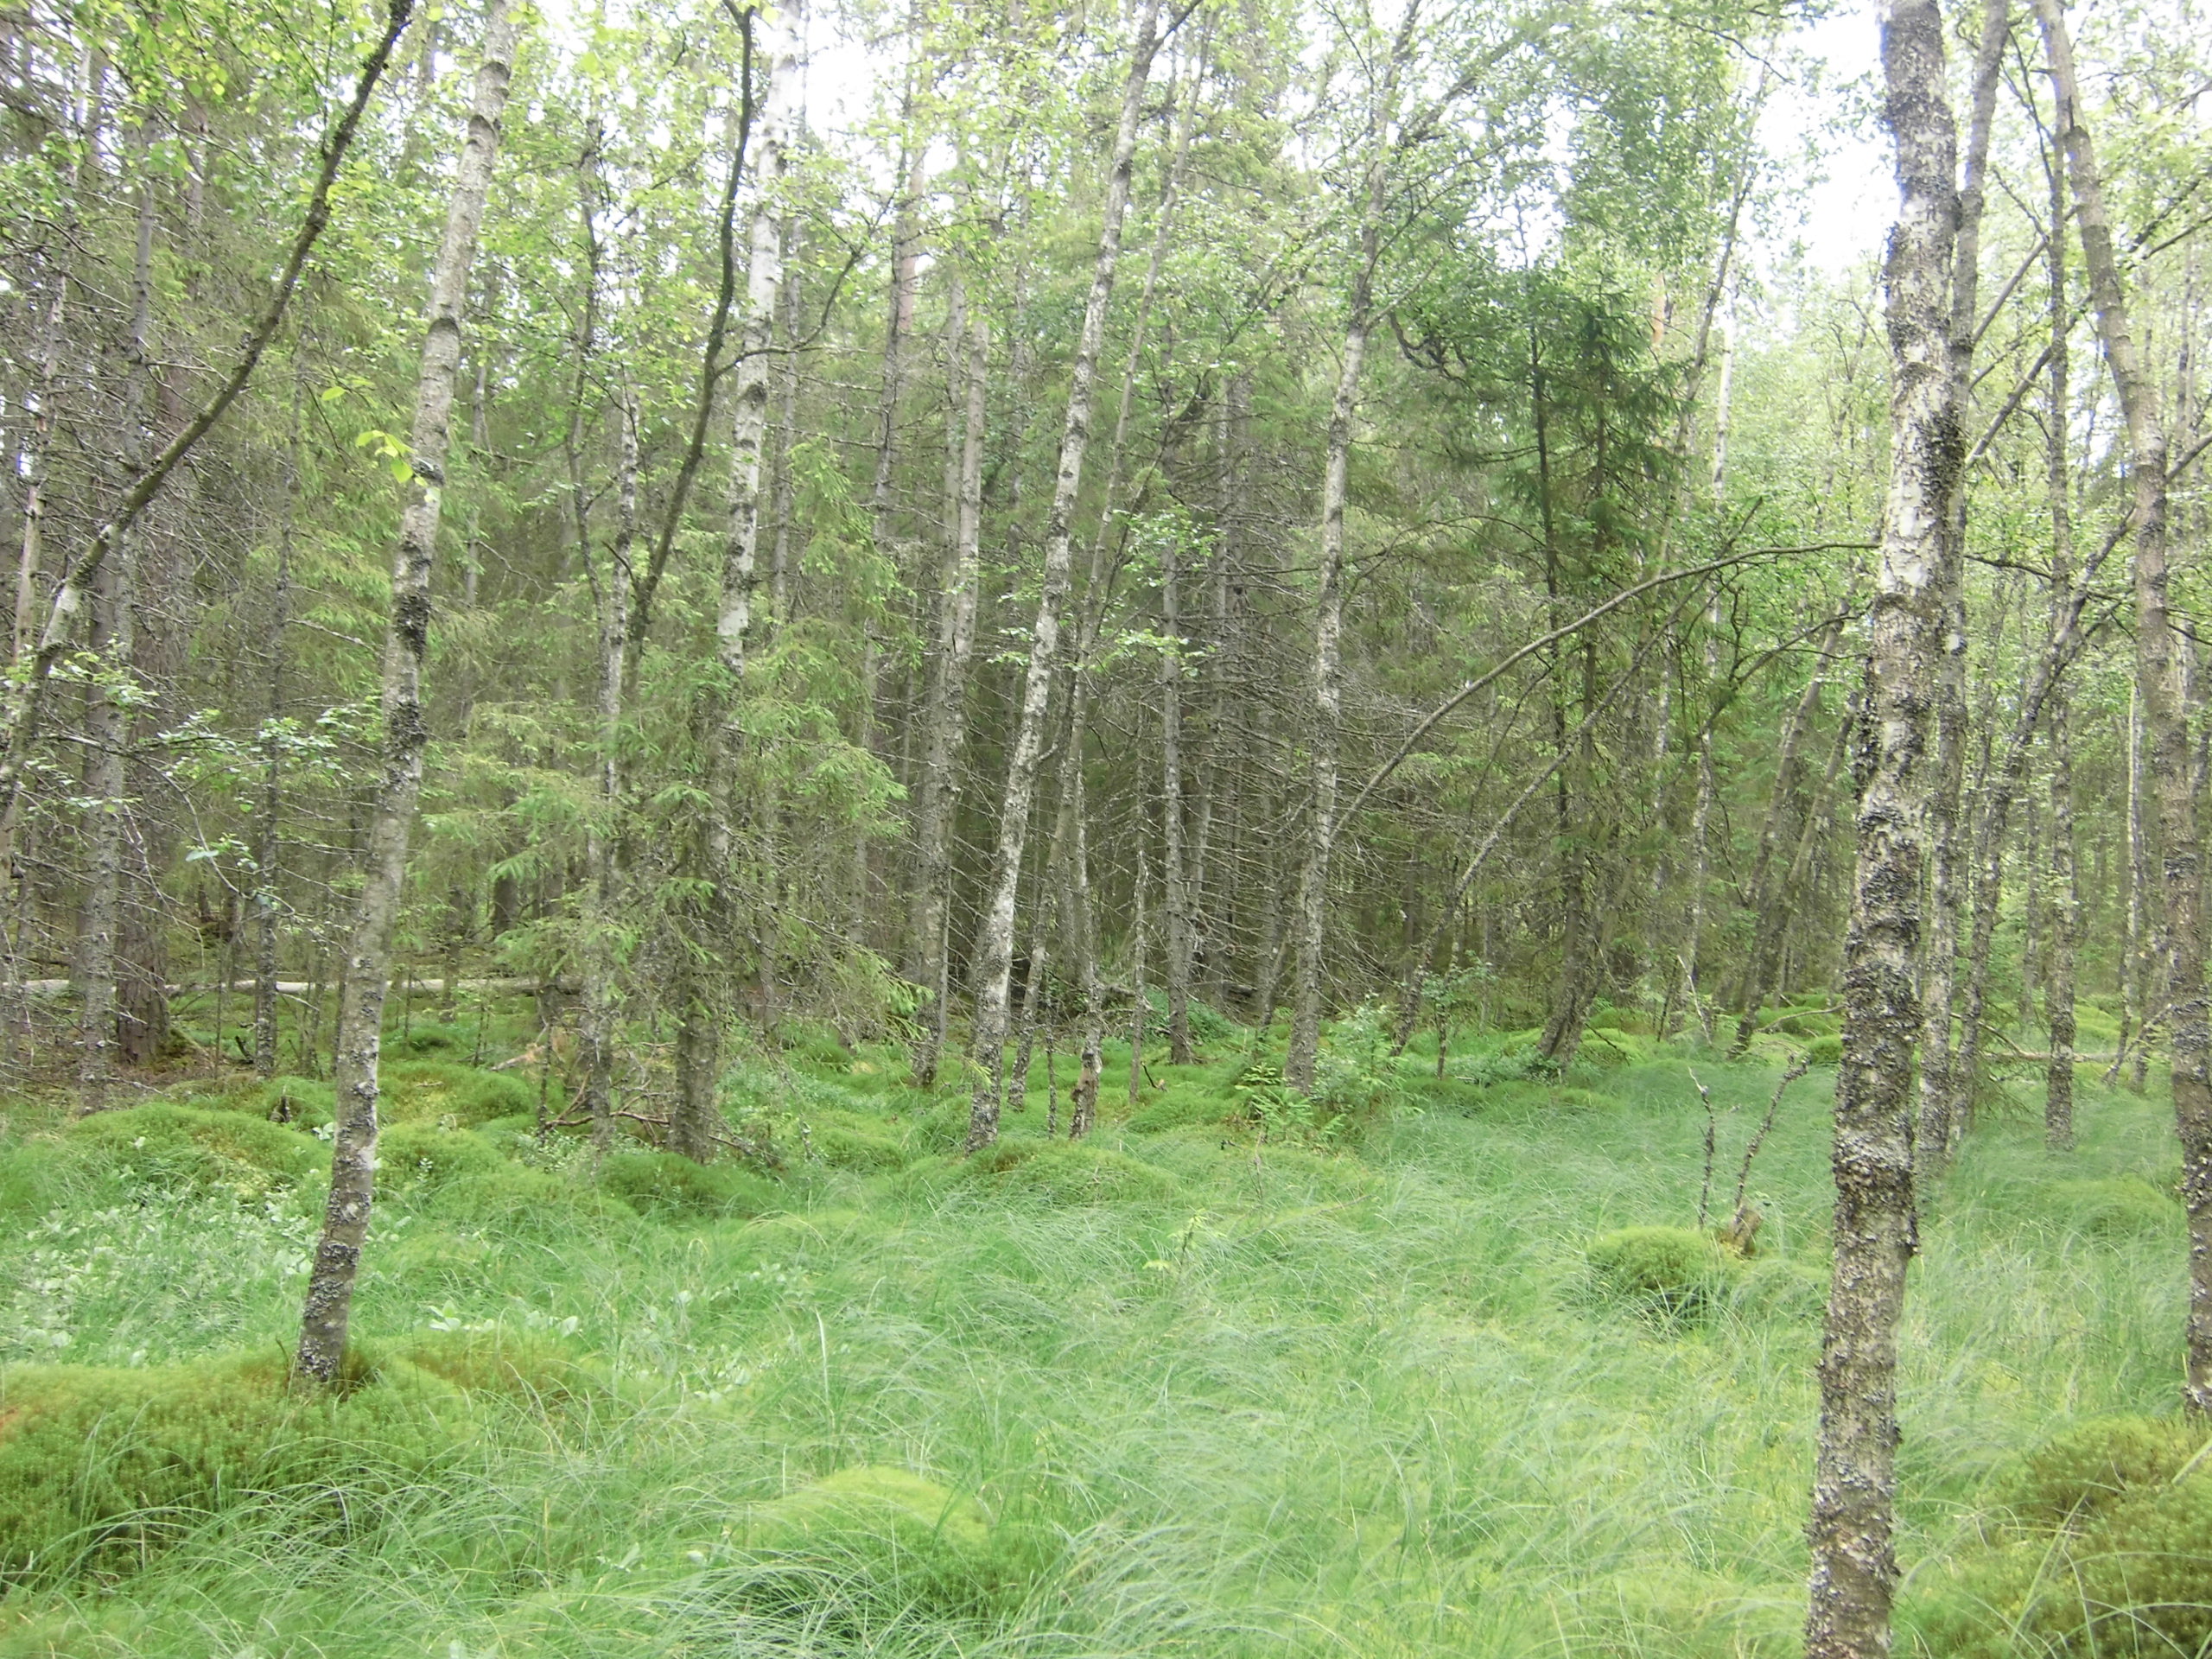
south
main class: Woodland
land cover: Broadleaved woodland
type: mire and swamp forests
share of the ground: 50 - 75 %
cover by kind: broadleaved forest trees 50 %, herbaceous plants 20 %, lichens and mosses 20 %, coniferous forest trees 5 %, shrubs 5 %
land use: Forestry
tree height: > 5 m
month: July
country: SE
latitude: 57.3590
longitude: 14.8003
